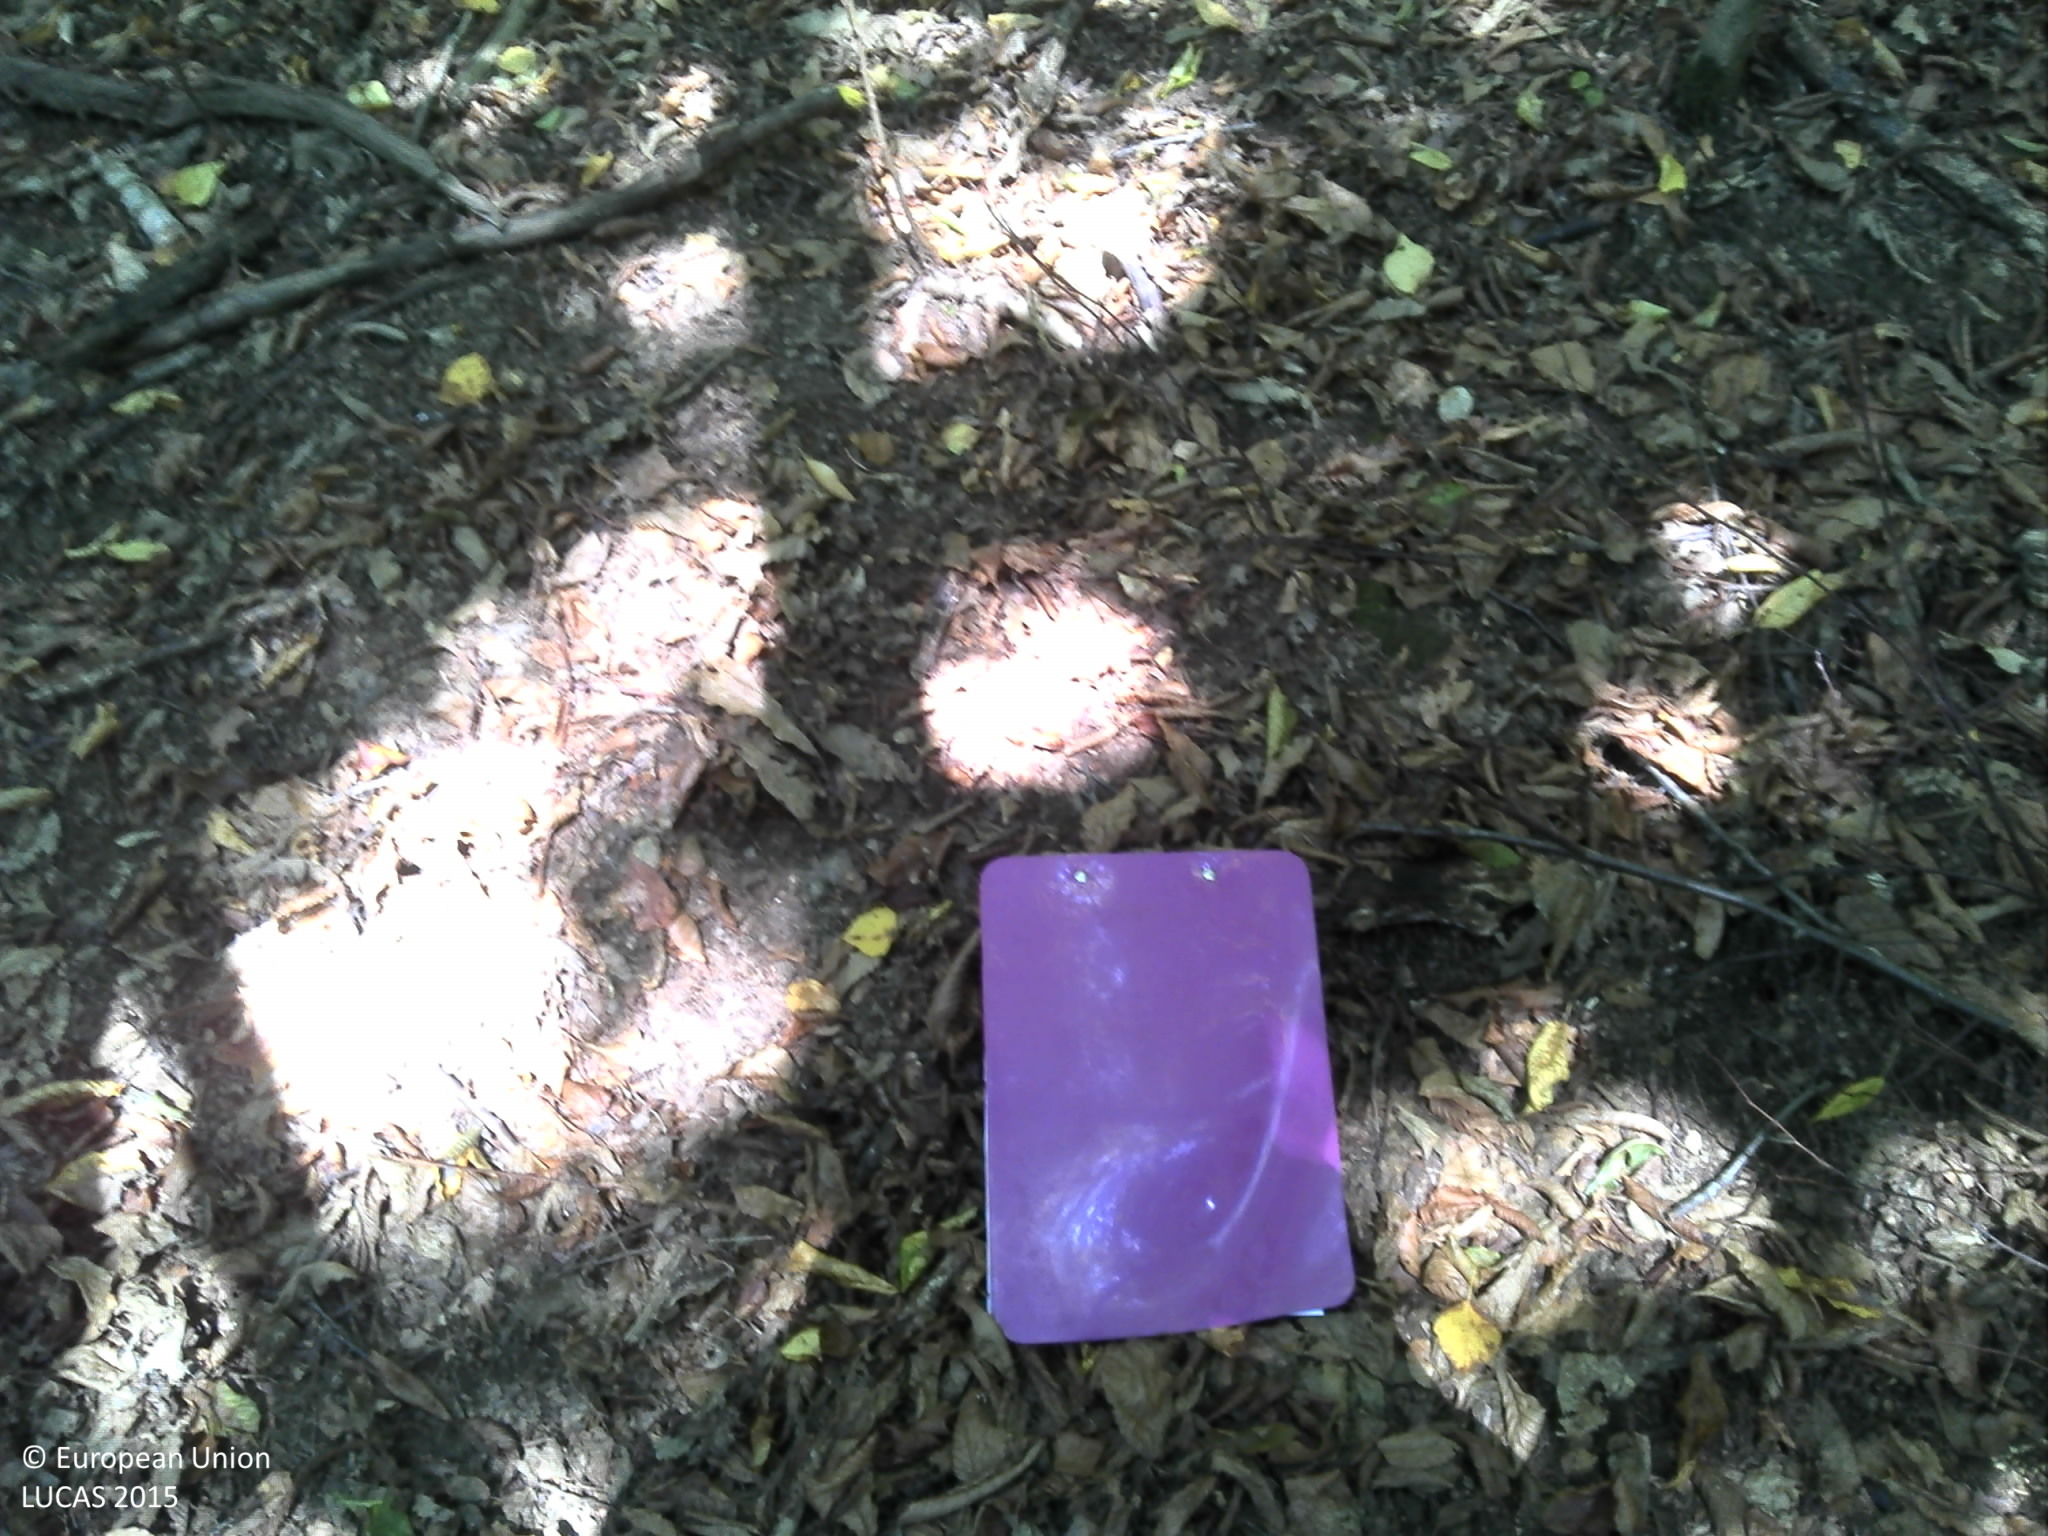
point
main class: Woodland
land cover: Broadleaved woodland
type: beech forest
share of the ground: > 75 %
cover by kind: broadleaved forest trees 100 %
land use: Forestry
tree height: > 5 m
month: August
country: HR
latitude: 45.2407
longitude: 16.3539
